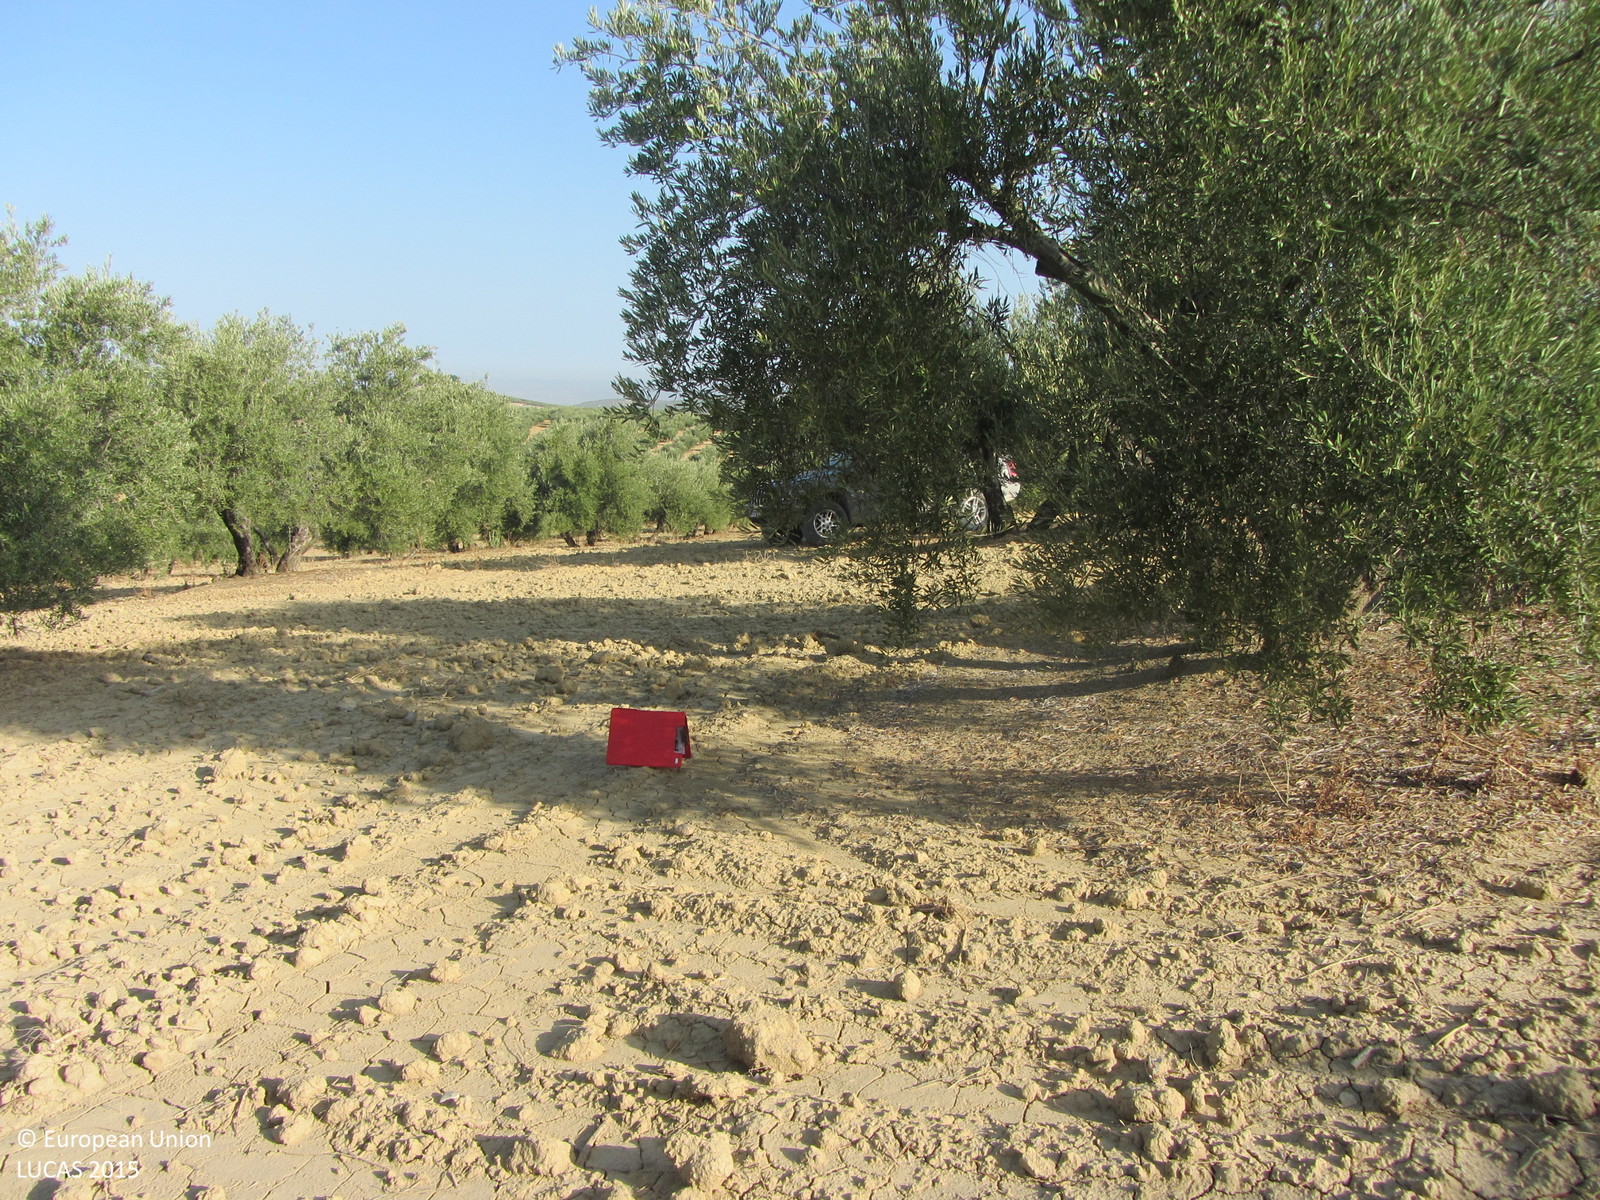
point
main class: Cropland
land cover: Olive groves
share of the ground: 25 - 50 %
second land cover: Other bare soil
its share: > 75 %
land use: Agriculture (excluding fallow land and kitchen gardens)
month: July
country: ES
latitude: 37.9442
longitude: -4.1980
